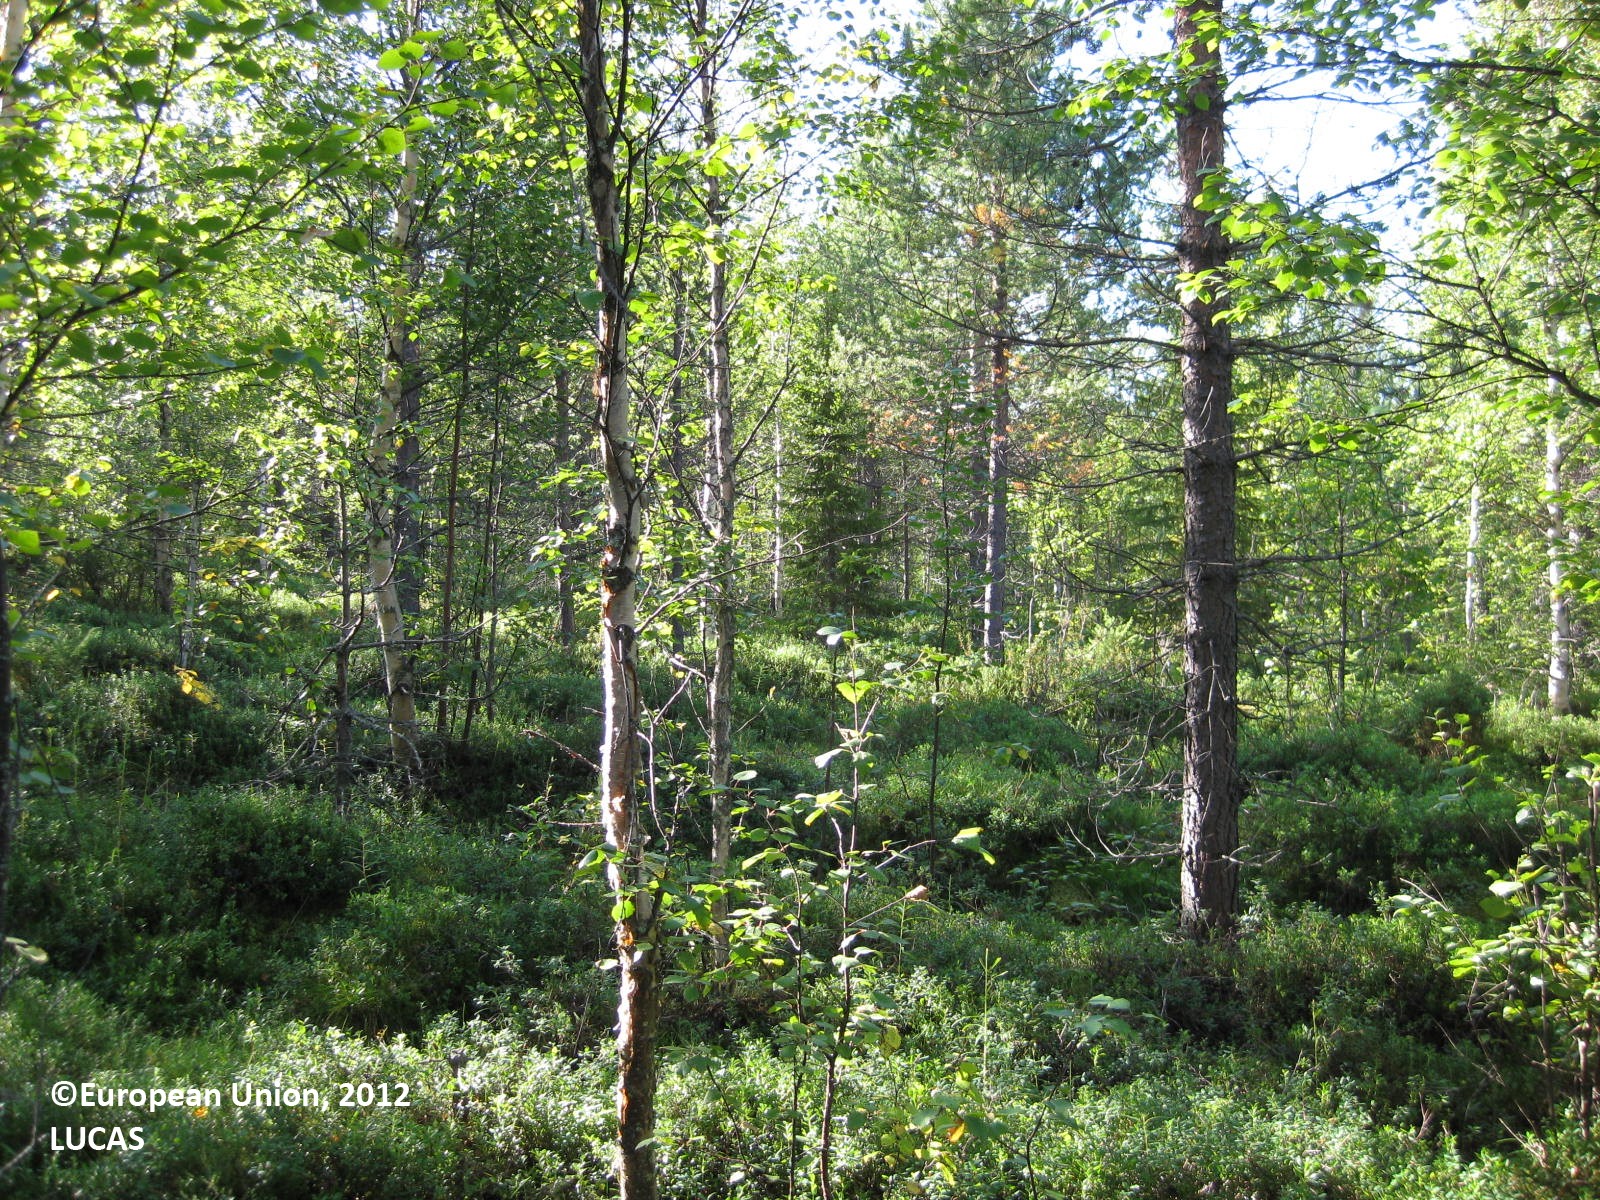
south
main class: Woodland
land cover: Pine dominated mixed woodland
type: boreal forest
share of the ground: > 75 %
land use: Forestry
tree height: > 5 m
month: August
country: FI
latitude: 66.6641
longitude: 29.1464
